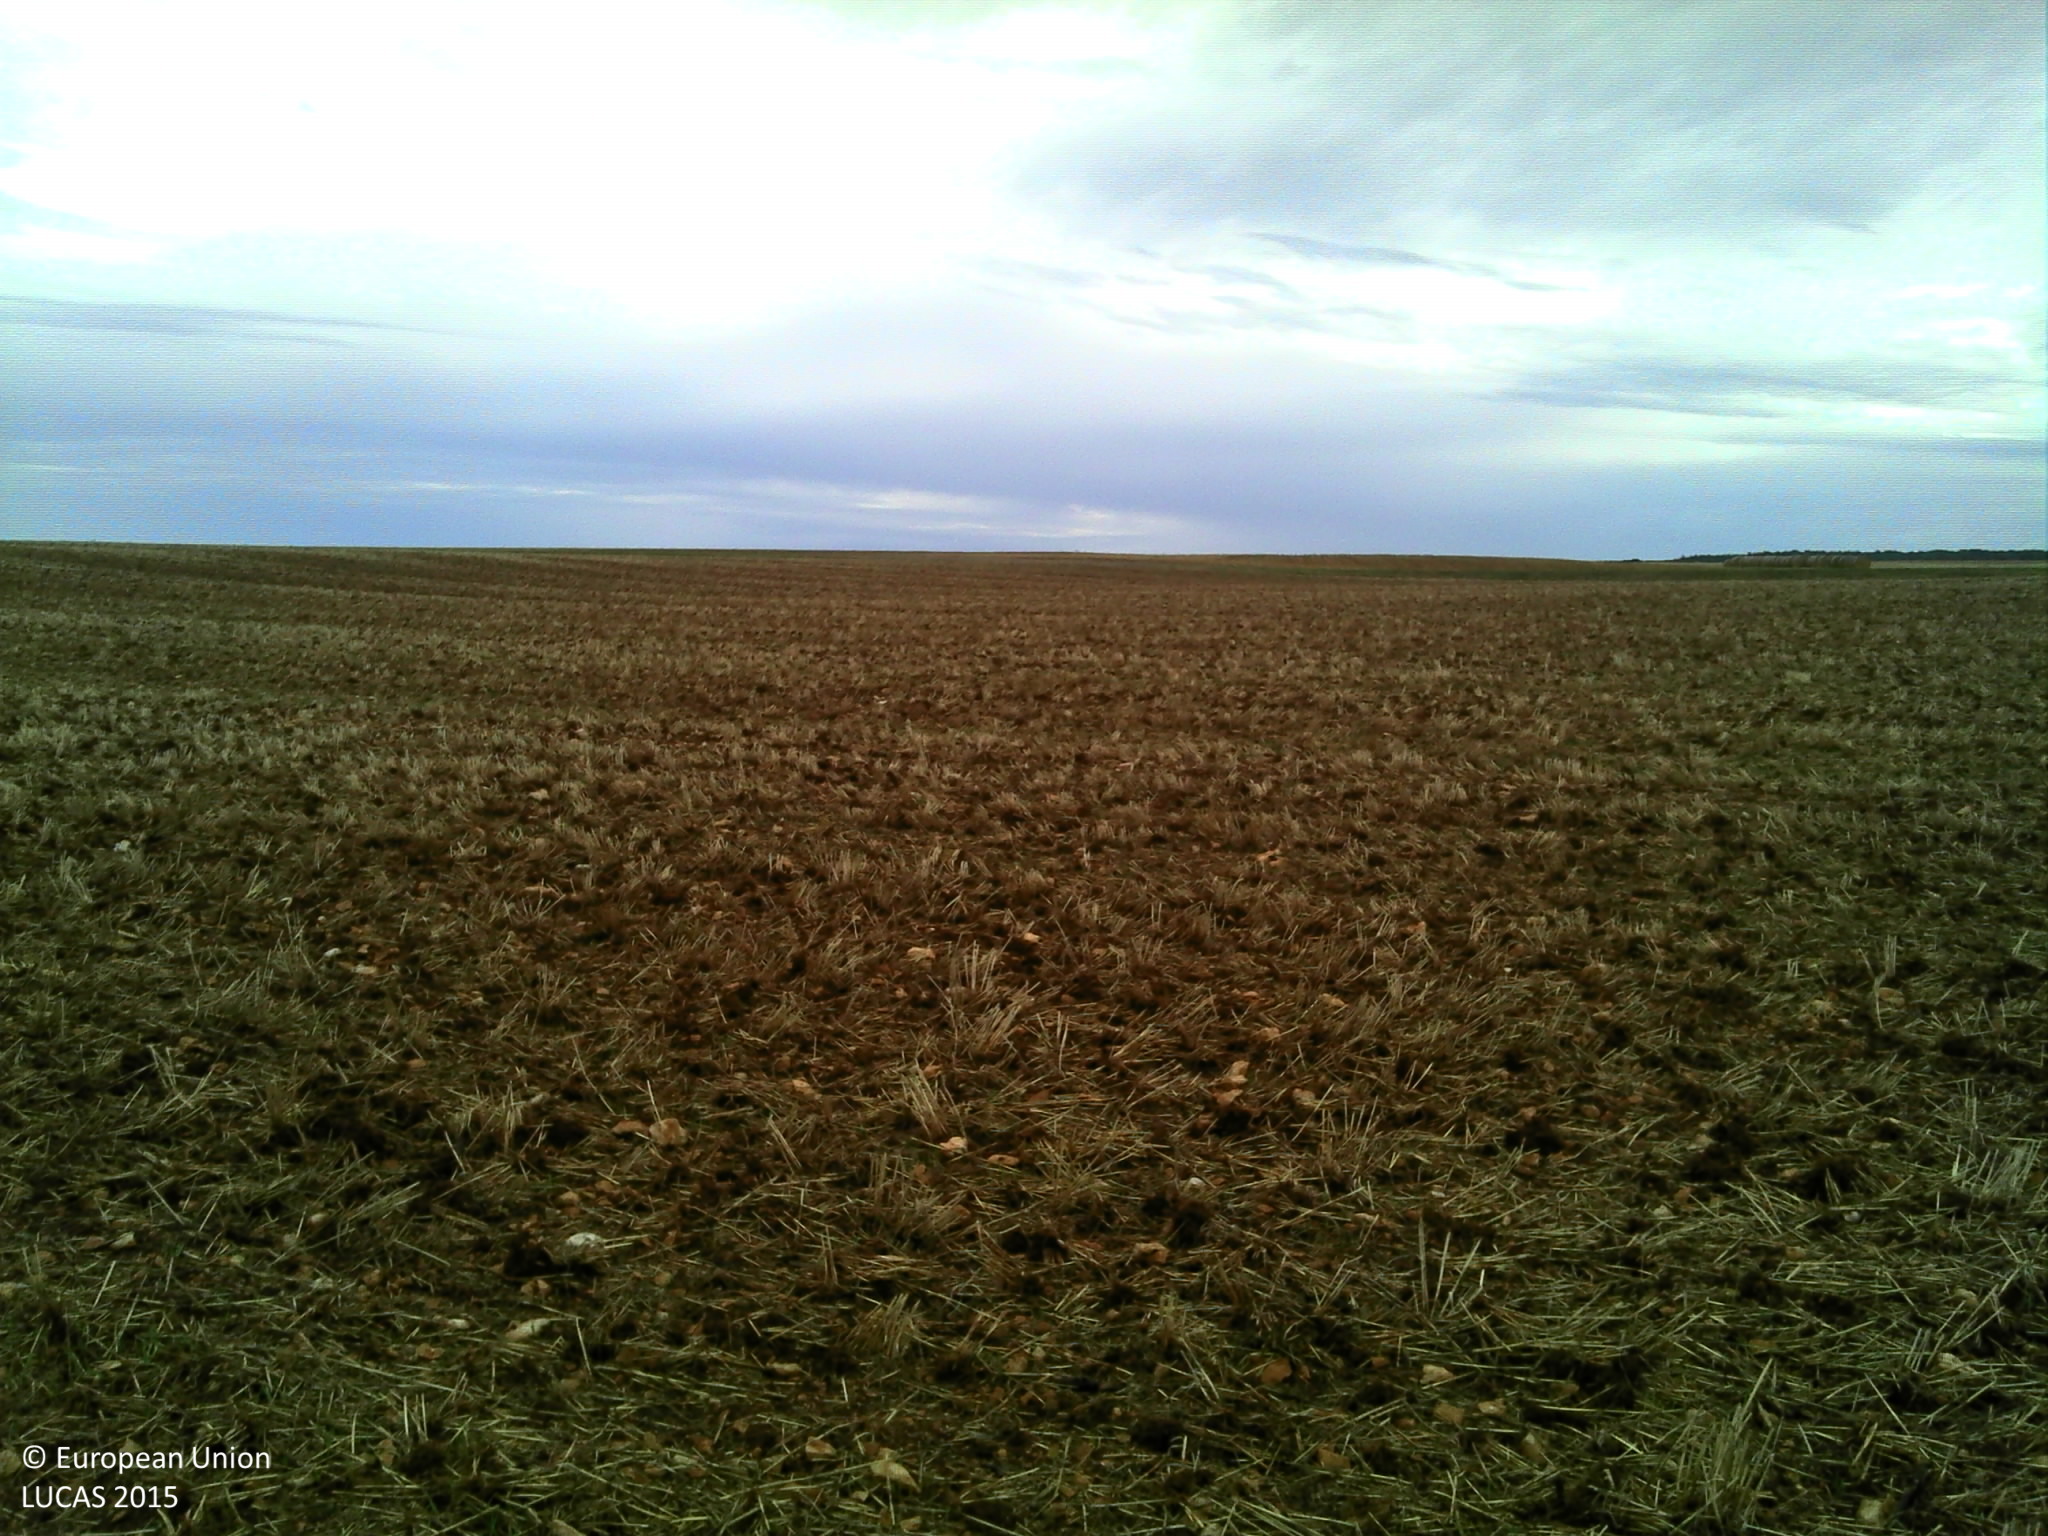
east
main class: Cropland
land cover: Common wheat
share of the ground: 10 - 25 %
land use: Agriculture (excluding fallow land and kitchen gardens)
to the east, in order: Common wheat; Electric lines; Common wheat; Grass margins; Paved roads, cycling and walking lanes; Grass margins; Maize
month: August
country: FR
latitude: 47.8972
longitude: 4.6884
